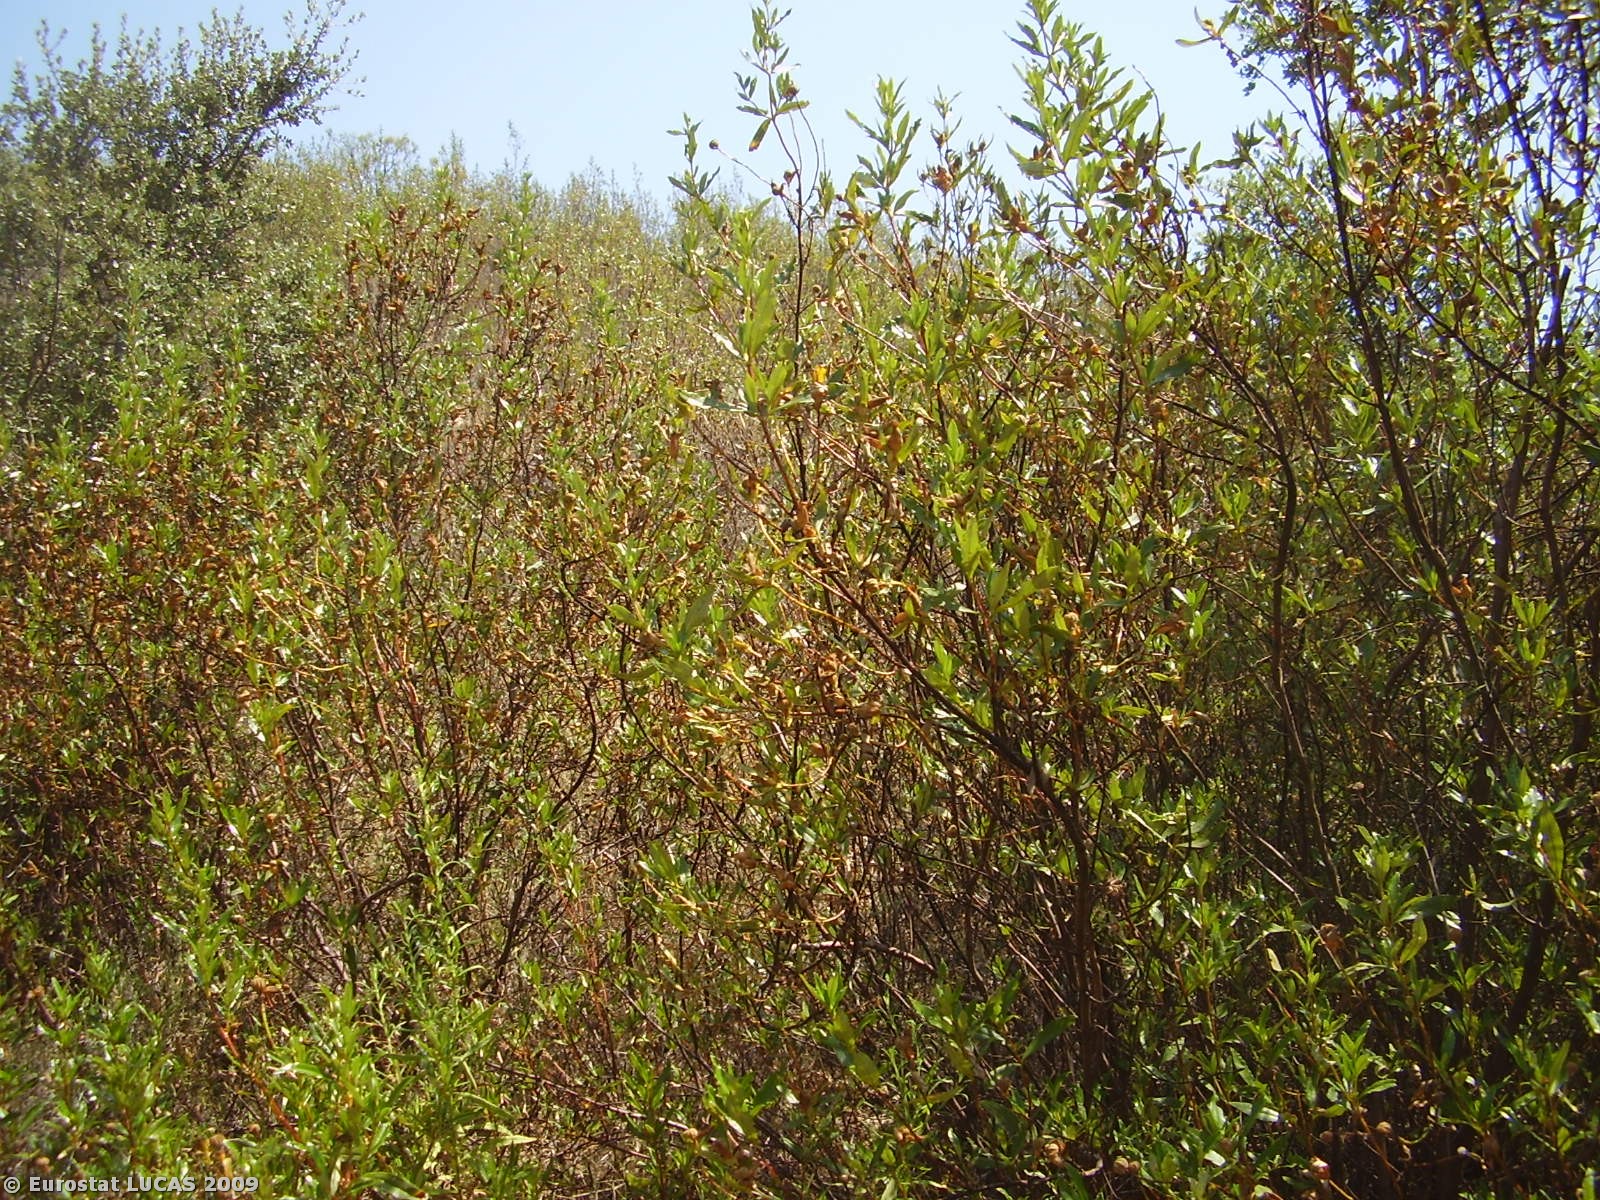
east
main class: Shrubland
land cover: Shrubland with sparse tree cover
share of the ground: > 75 %
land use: Fallow land
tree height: > 5 m
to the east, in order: Shrubland with sparse tree cover; Tracks; Broadleaved woodland; Tracks; Broadleaved woodland; Tracks; Broadleaved woodland; Tracks; Fences; Broadleaved woodland
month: August
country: PT
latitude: 37.6305
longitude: -8.3543
